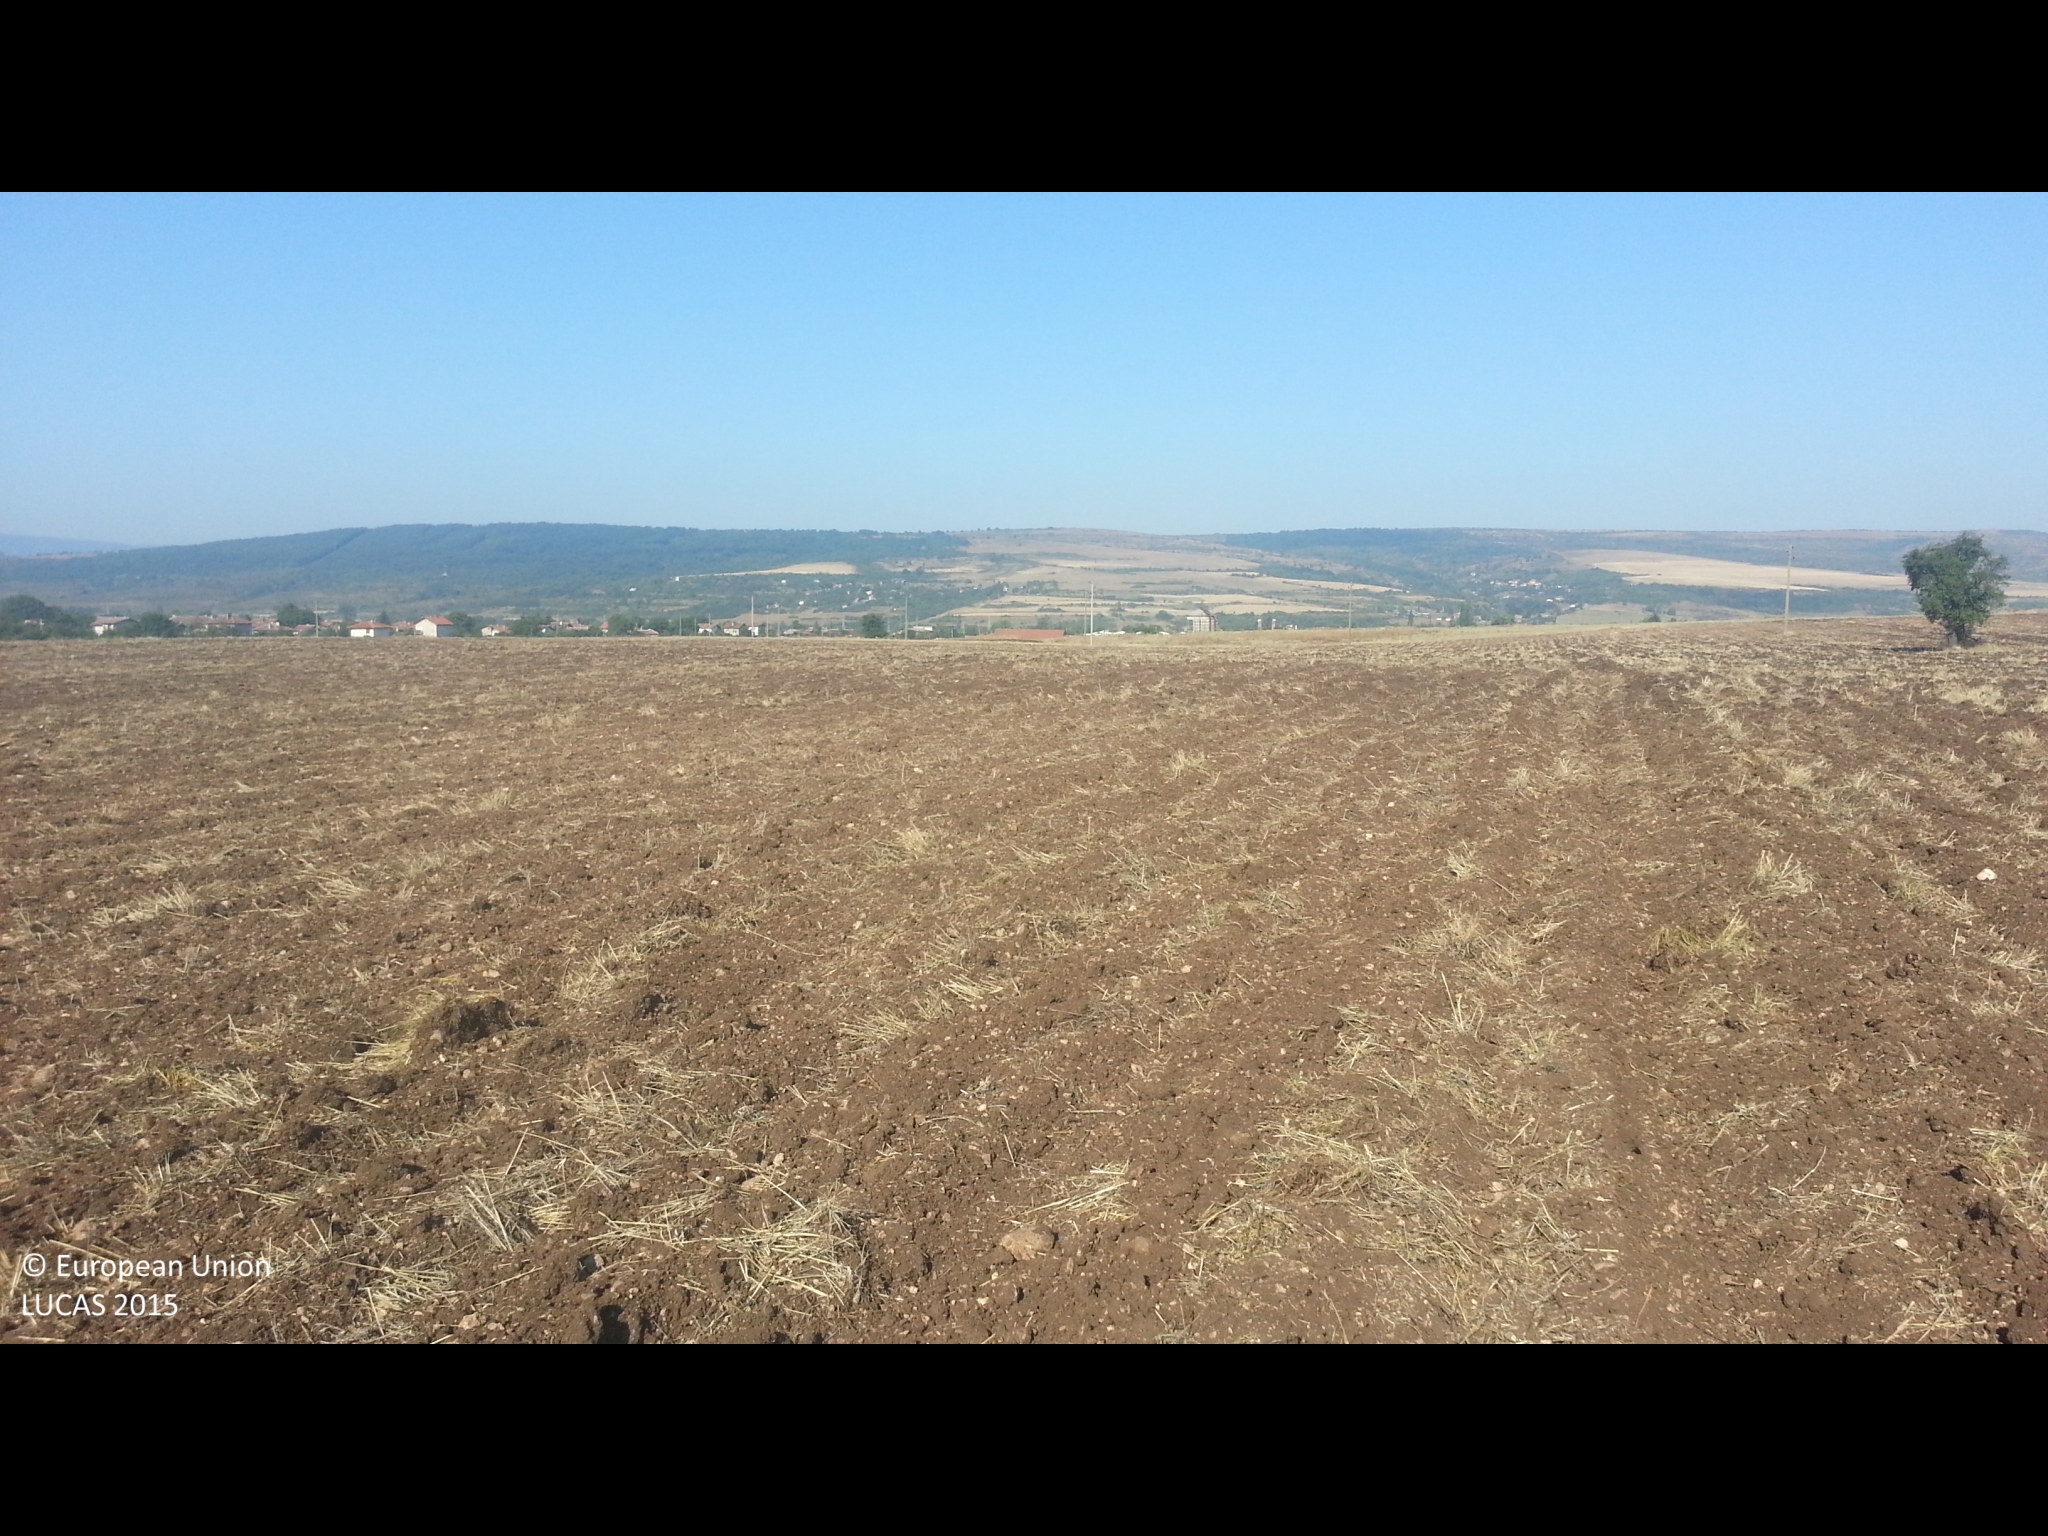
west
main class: Cropland
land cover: Common wheat
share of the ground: < 10 %
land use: Agriculture (excluding fallow land and kitchen gardens)
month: August
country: BG
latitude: 42.5287
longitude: 22.9688
